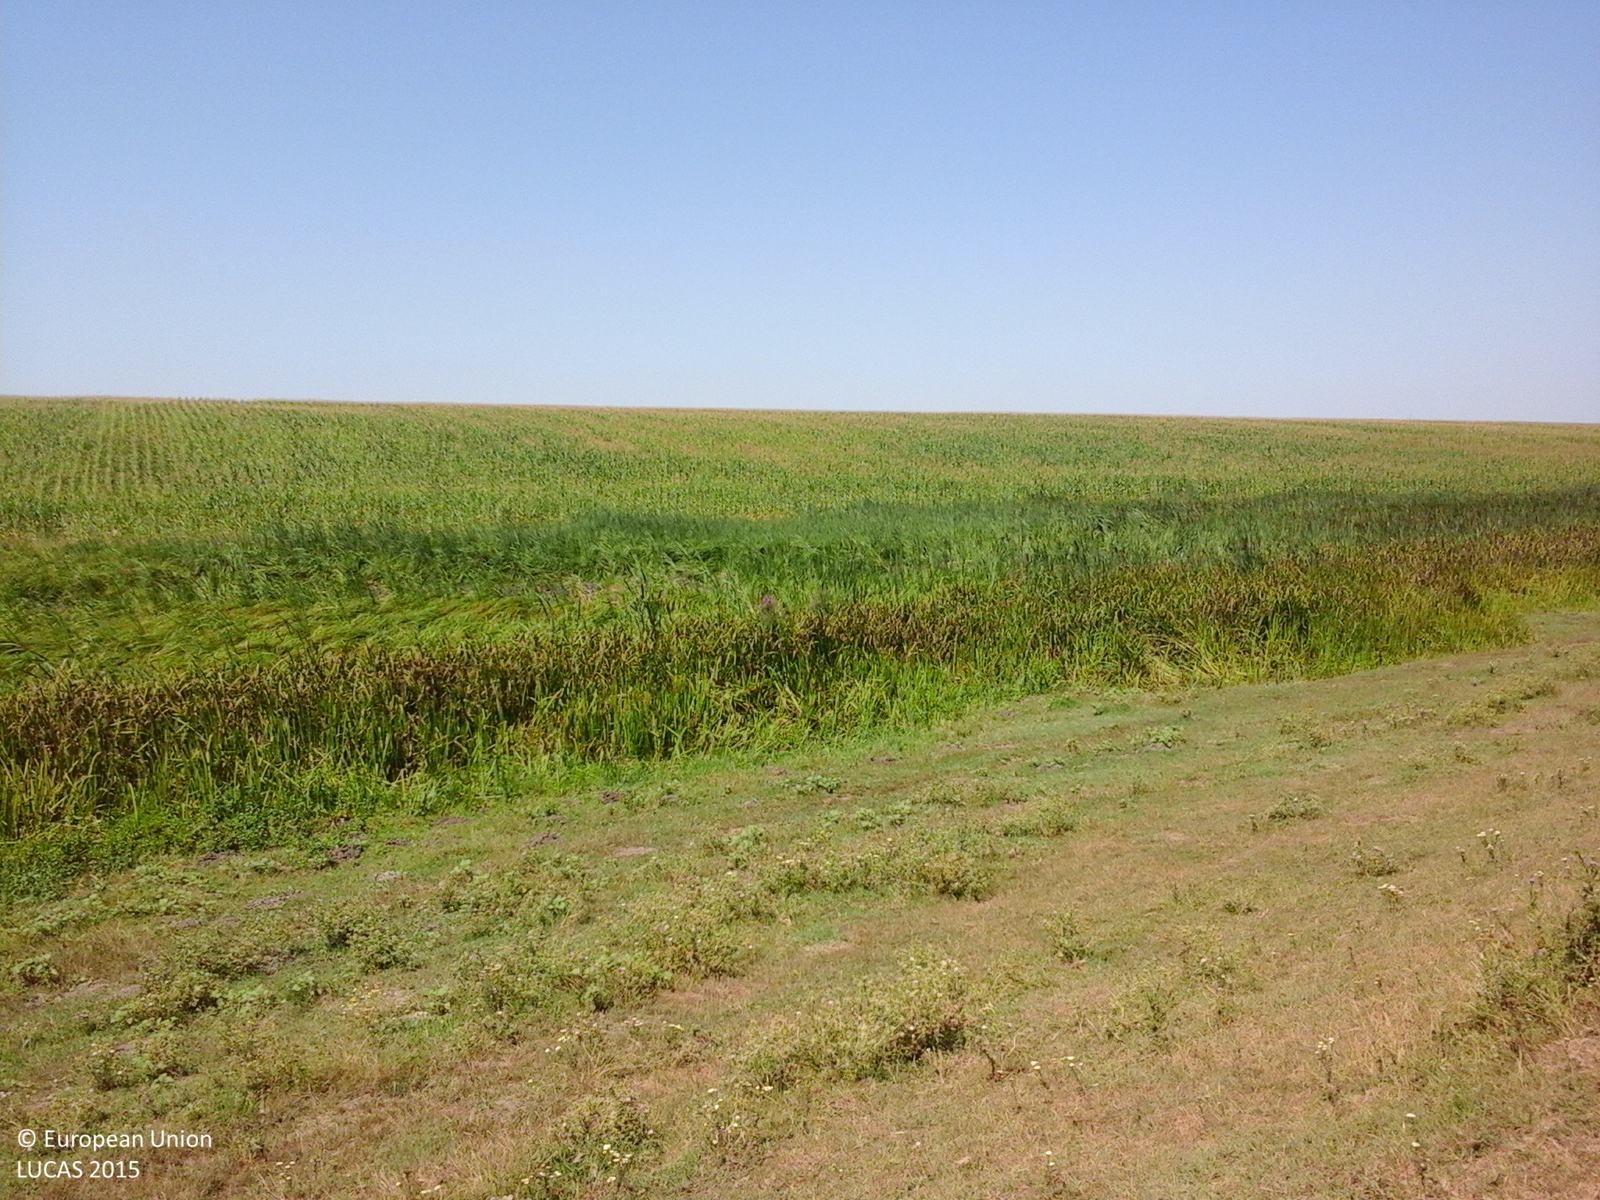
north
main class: Grassland
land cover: Grassland without tree/shrub cover
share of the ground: > 75 %
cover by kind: herbaceous plants 100 %
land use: Agriculture (excluding fallow land and kitchen gardens)
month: July
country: RO
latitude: 44.3853
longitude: 26.5725
